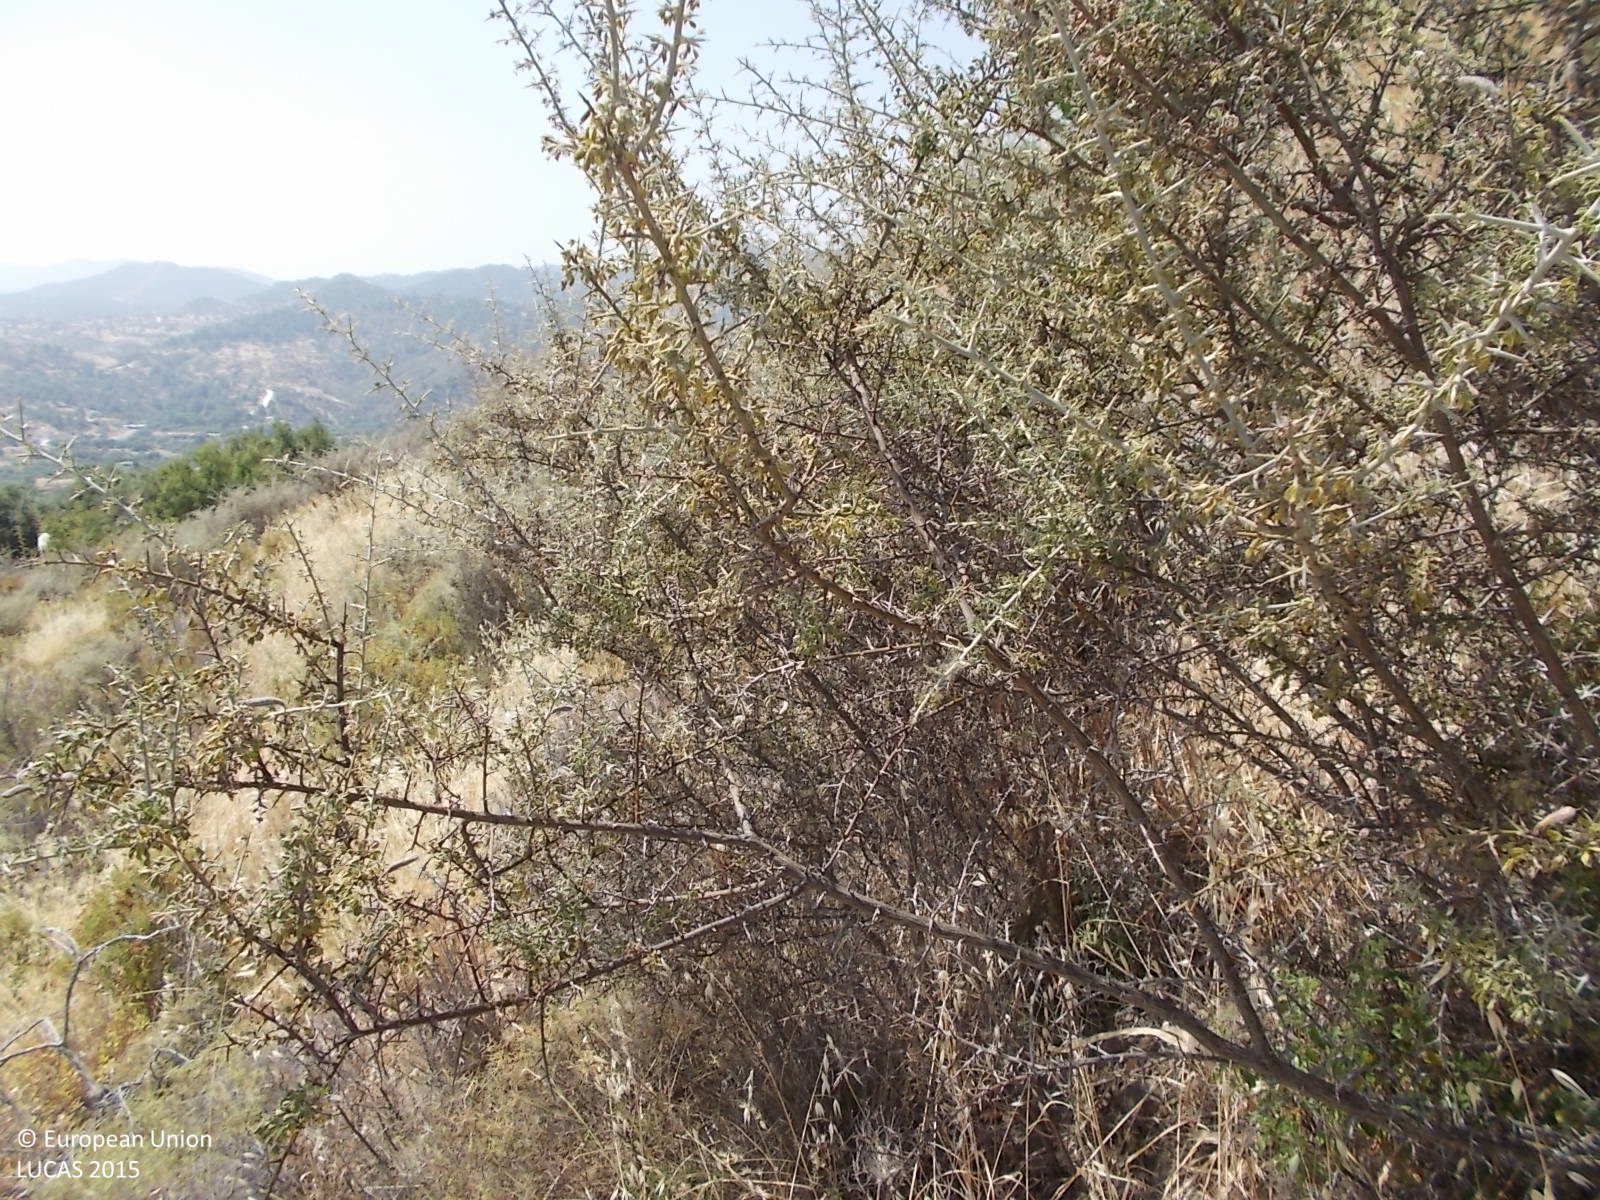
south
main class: Shrubland
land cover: Shrubland without tree cover
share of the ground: 25 - 50 %
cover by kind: herbaceous plants 55 %, shrubs 35 %, unconsolidated bare surface 10 %
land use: Semi-natural and natural areas not in use
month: May
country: CY
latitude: 35.1784
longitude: 32.6663
